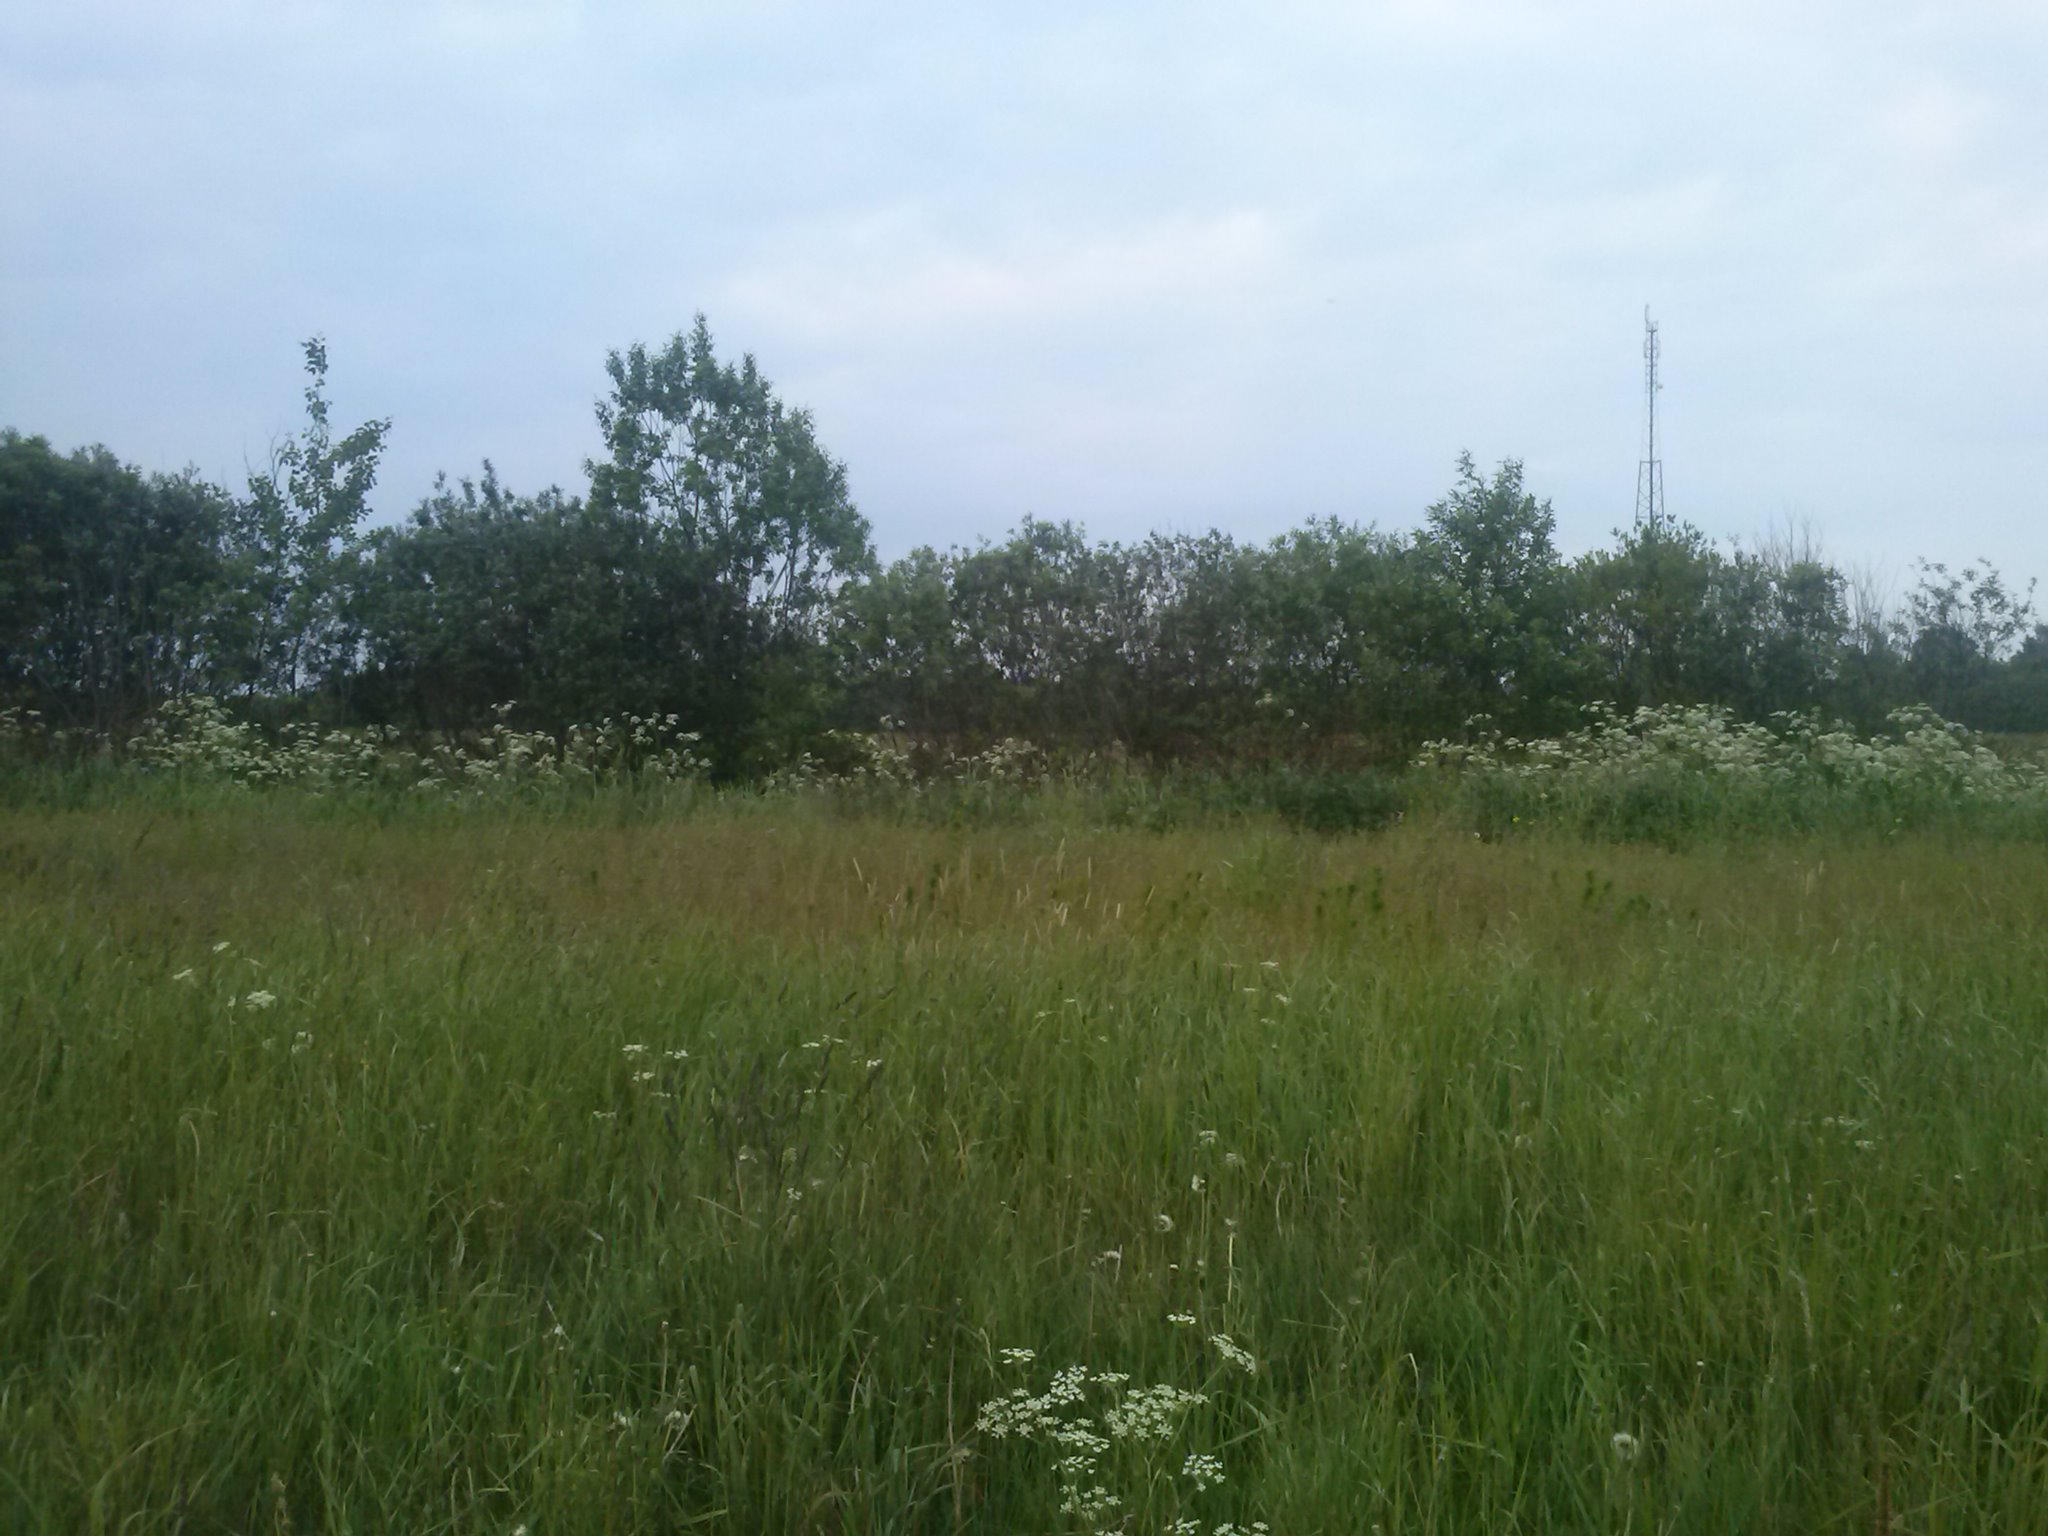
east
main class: Grassland
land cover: Grassland without tree/shrub cover
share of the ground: > 75 %
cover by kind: herbaceous plants 100 %
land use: Agriculture (excluding fallow land and kitchen gardens)
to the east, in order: Grassland without tree/shrub cover; Shruby margins; Ditches and canals; Abandoned hedges; Grassland without tree/shrub cover; Fences; Grassland without tree/shrub cover; Broadleaved woodland; Grassland with sparse tree/shrub cover; Grassland without tree/shrub cover
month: June
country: LV
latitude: 56.9297
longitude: 27.0714
